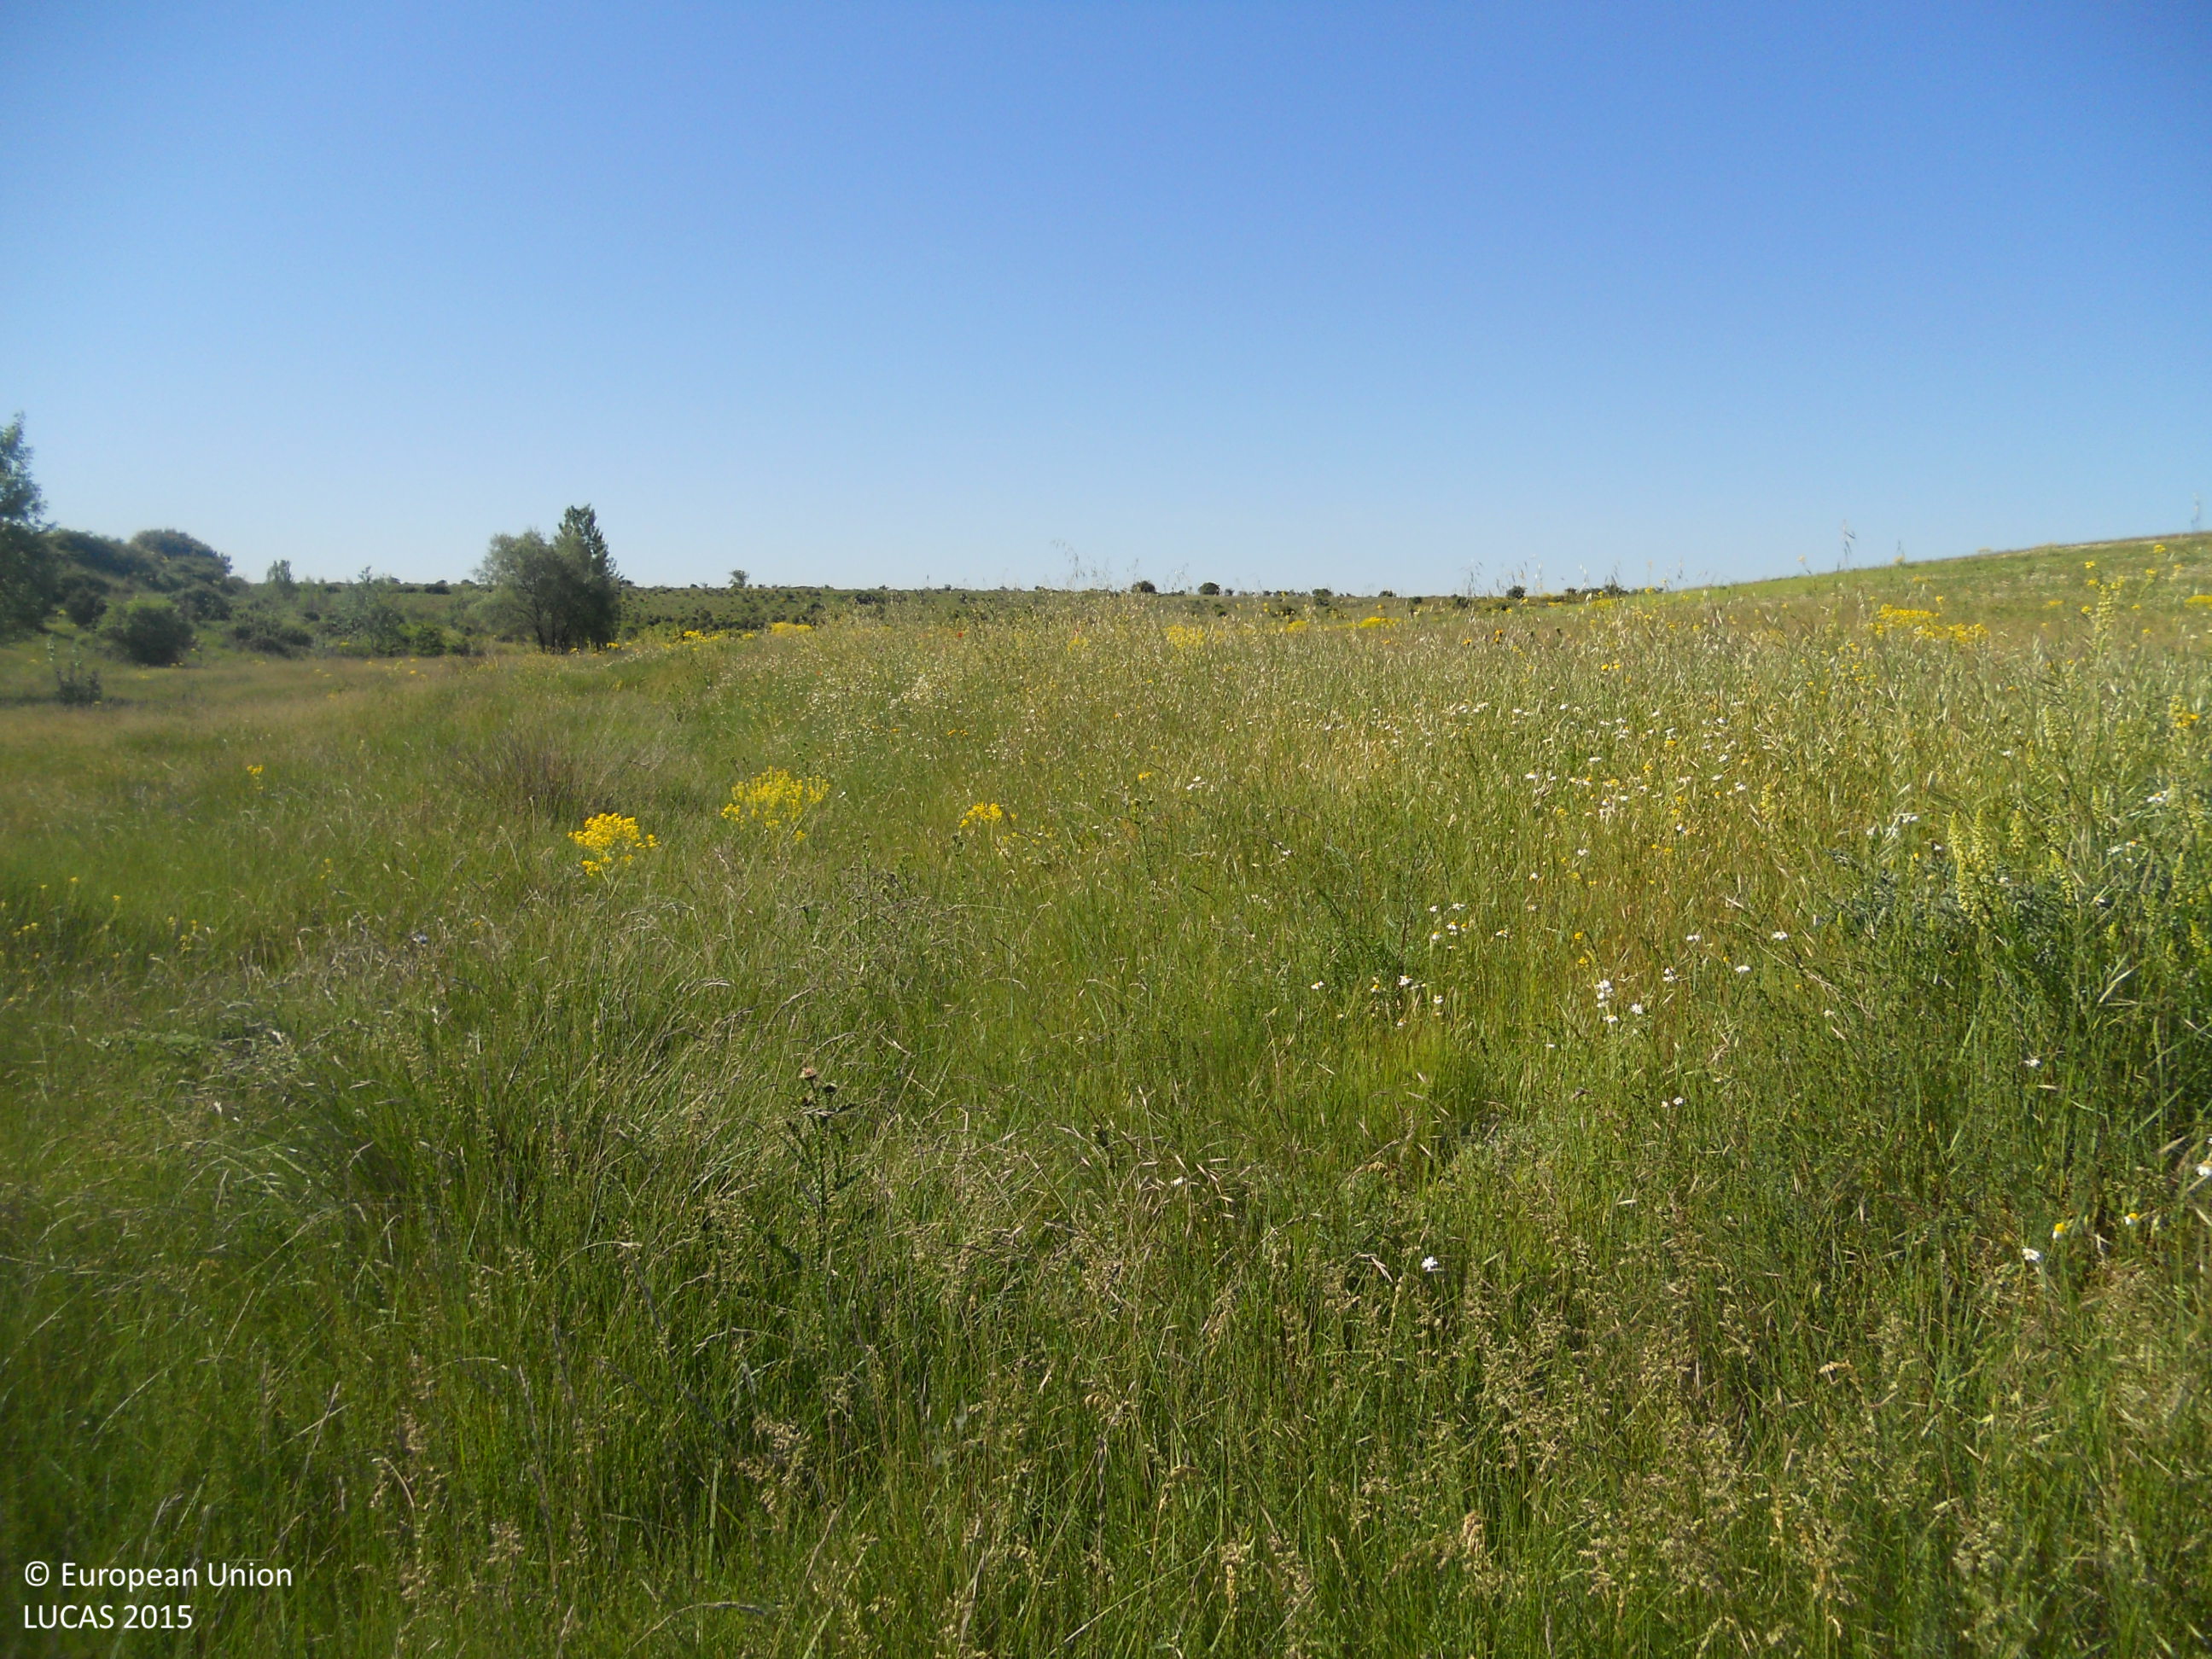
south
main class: Grassland
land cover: Grassland without tree/shrub cover
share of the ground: > 75 %
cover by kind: herbaceous plants 100 %
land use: Semi-natural and natural areas not in use
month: May
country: ES
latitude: 42.4504
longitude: -5.5737
